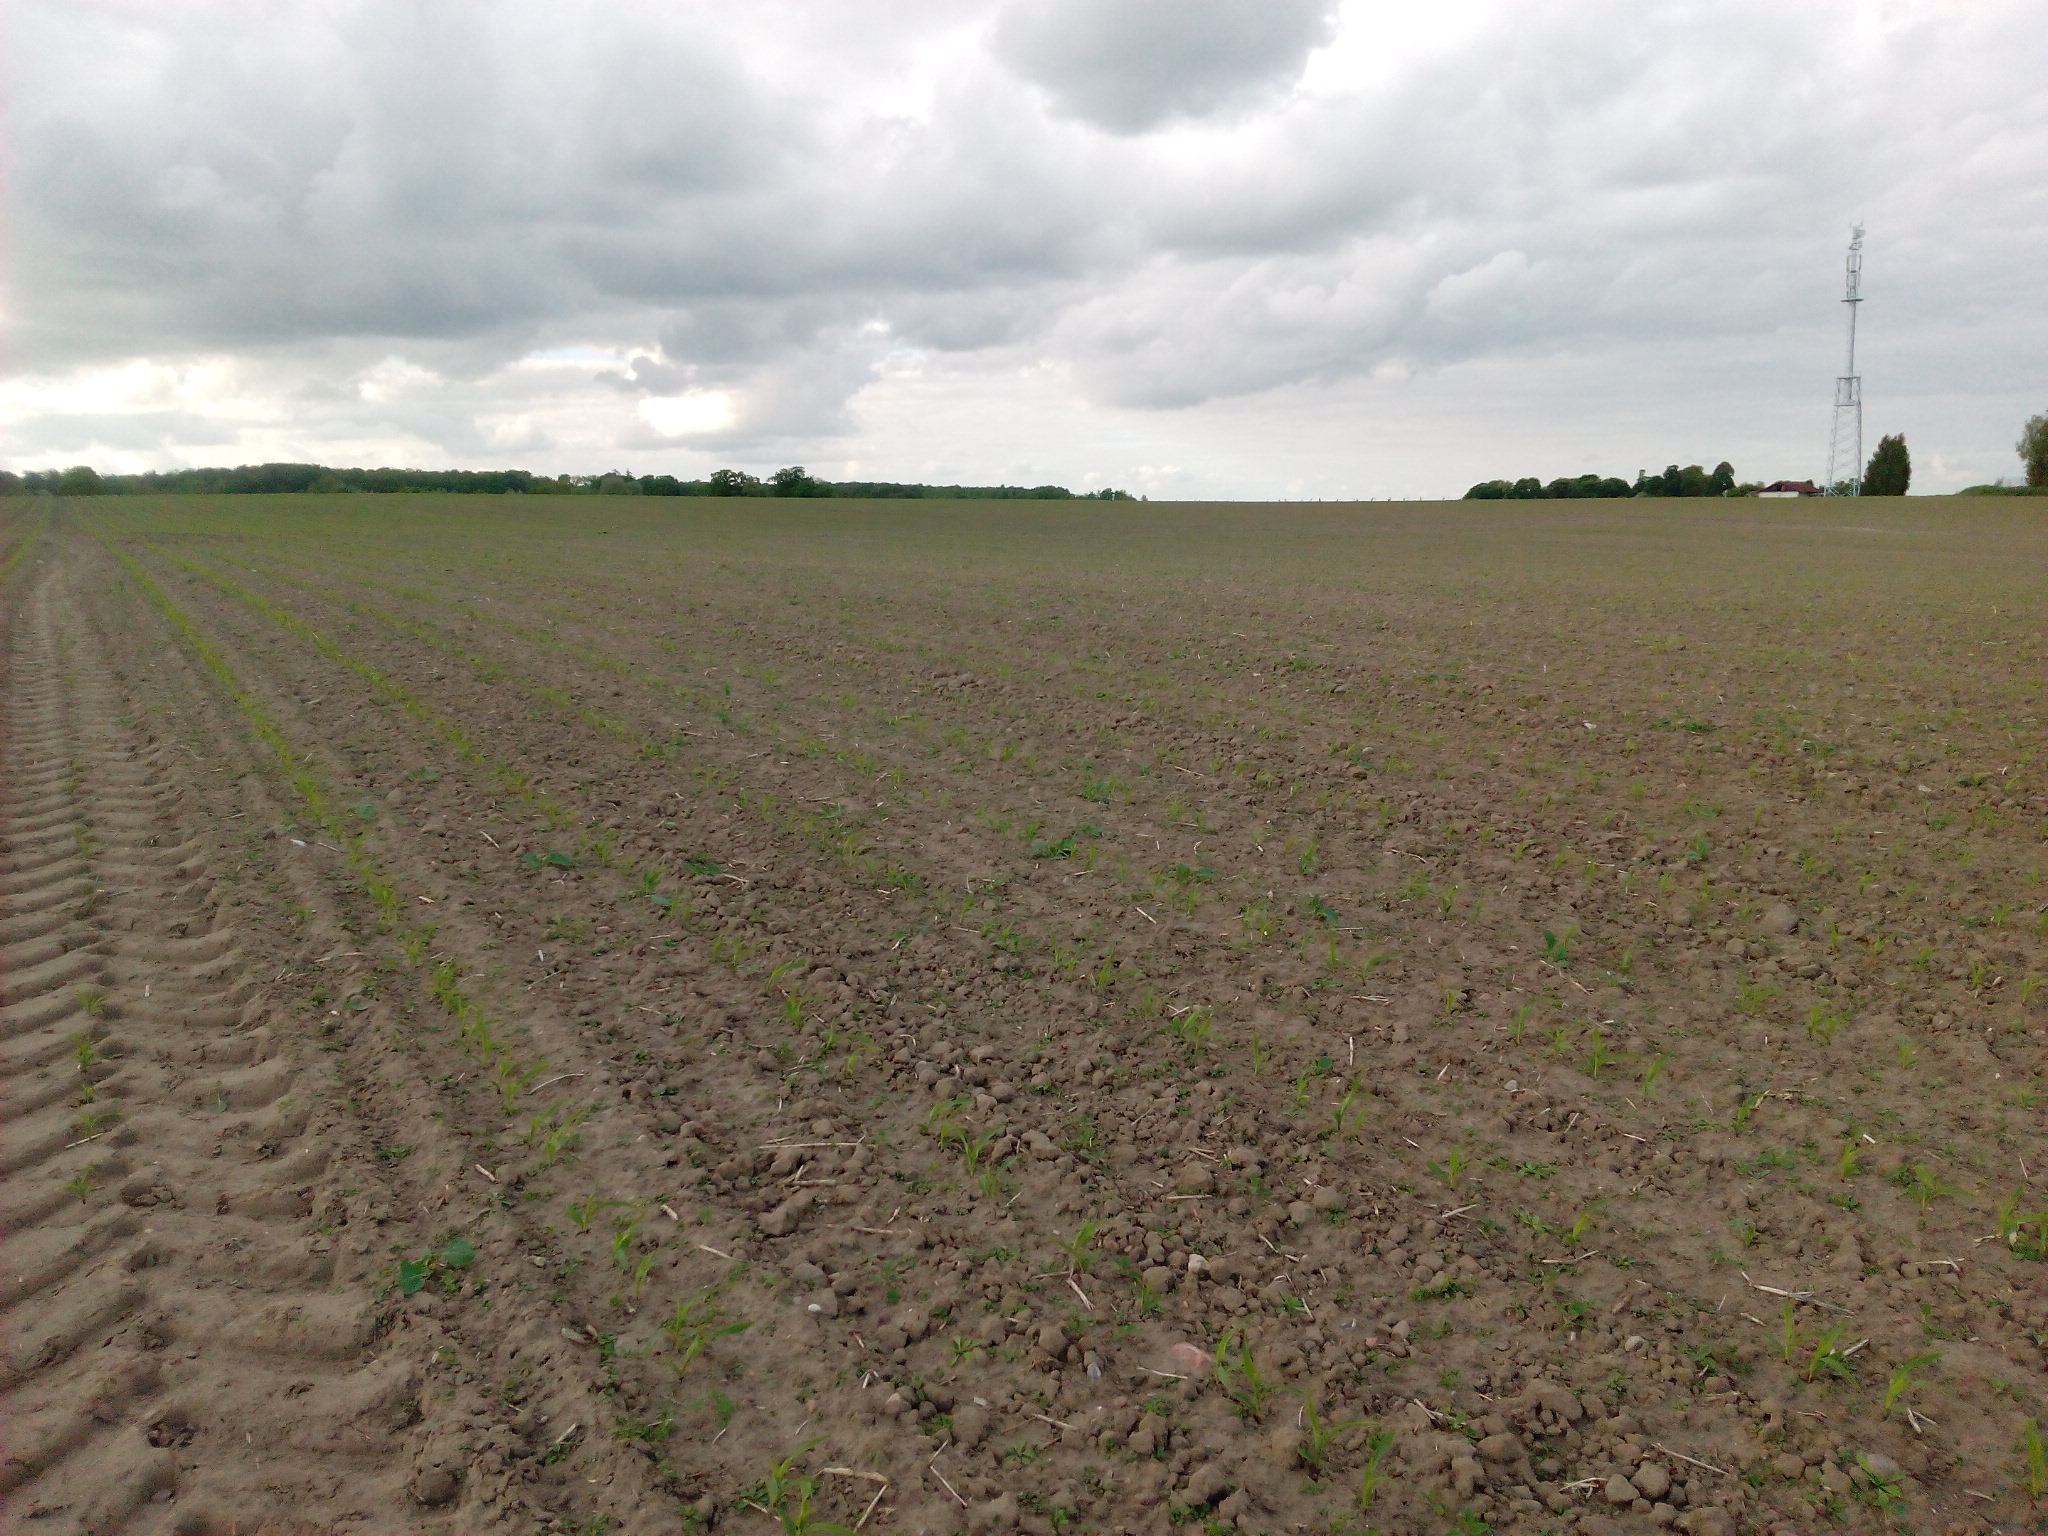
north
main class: Cropland
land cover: Maize
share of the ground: < 10 %
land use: Agriculture (excluding fallow land and kitchen gardens)
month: May
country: DE
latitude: 53.7718
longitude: 13.2616
